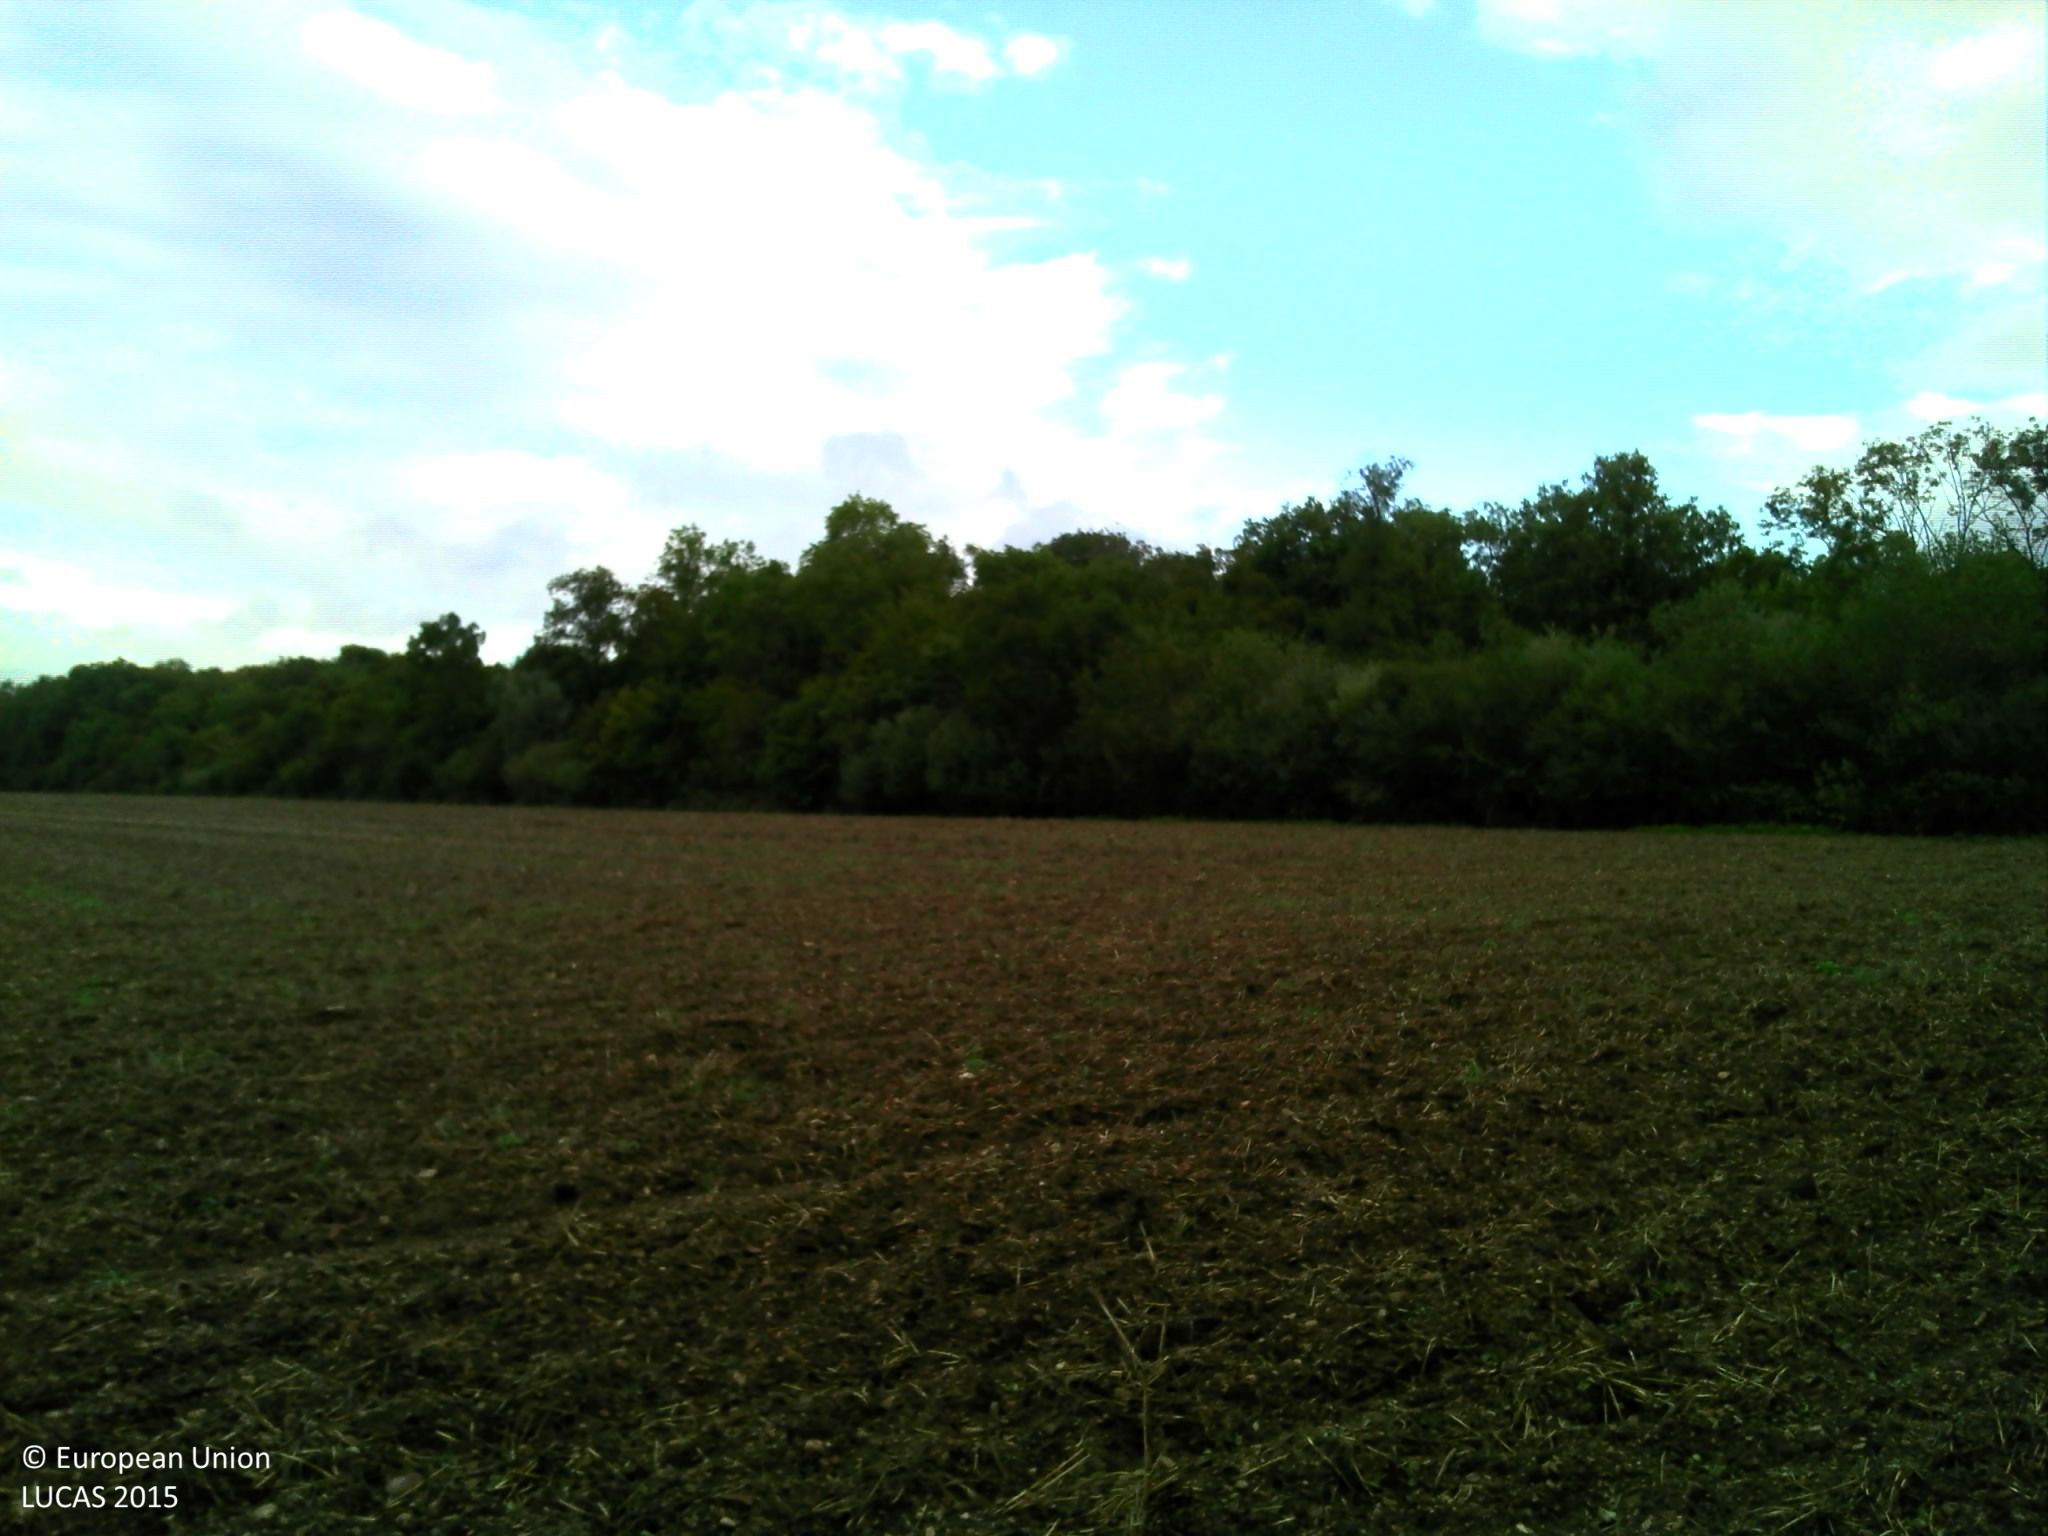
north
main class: Grassland
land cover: Grassland without tree/shrub cover
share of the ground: > 75 %
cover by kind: herbaceous plants 100 %
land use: Agriculture (excluding fallow land and kitchen gardens)
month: September
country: FR
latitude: 47.0814
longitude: 4.9827
